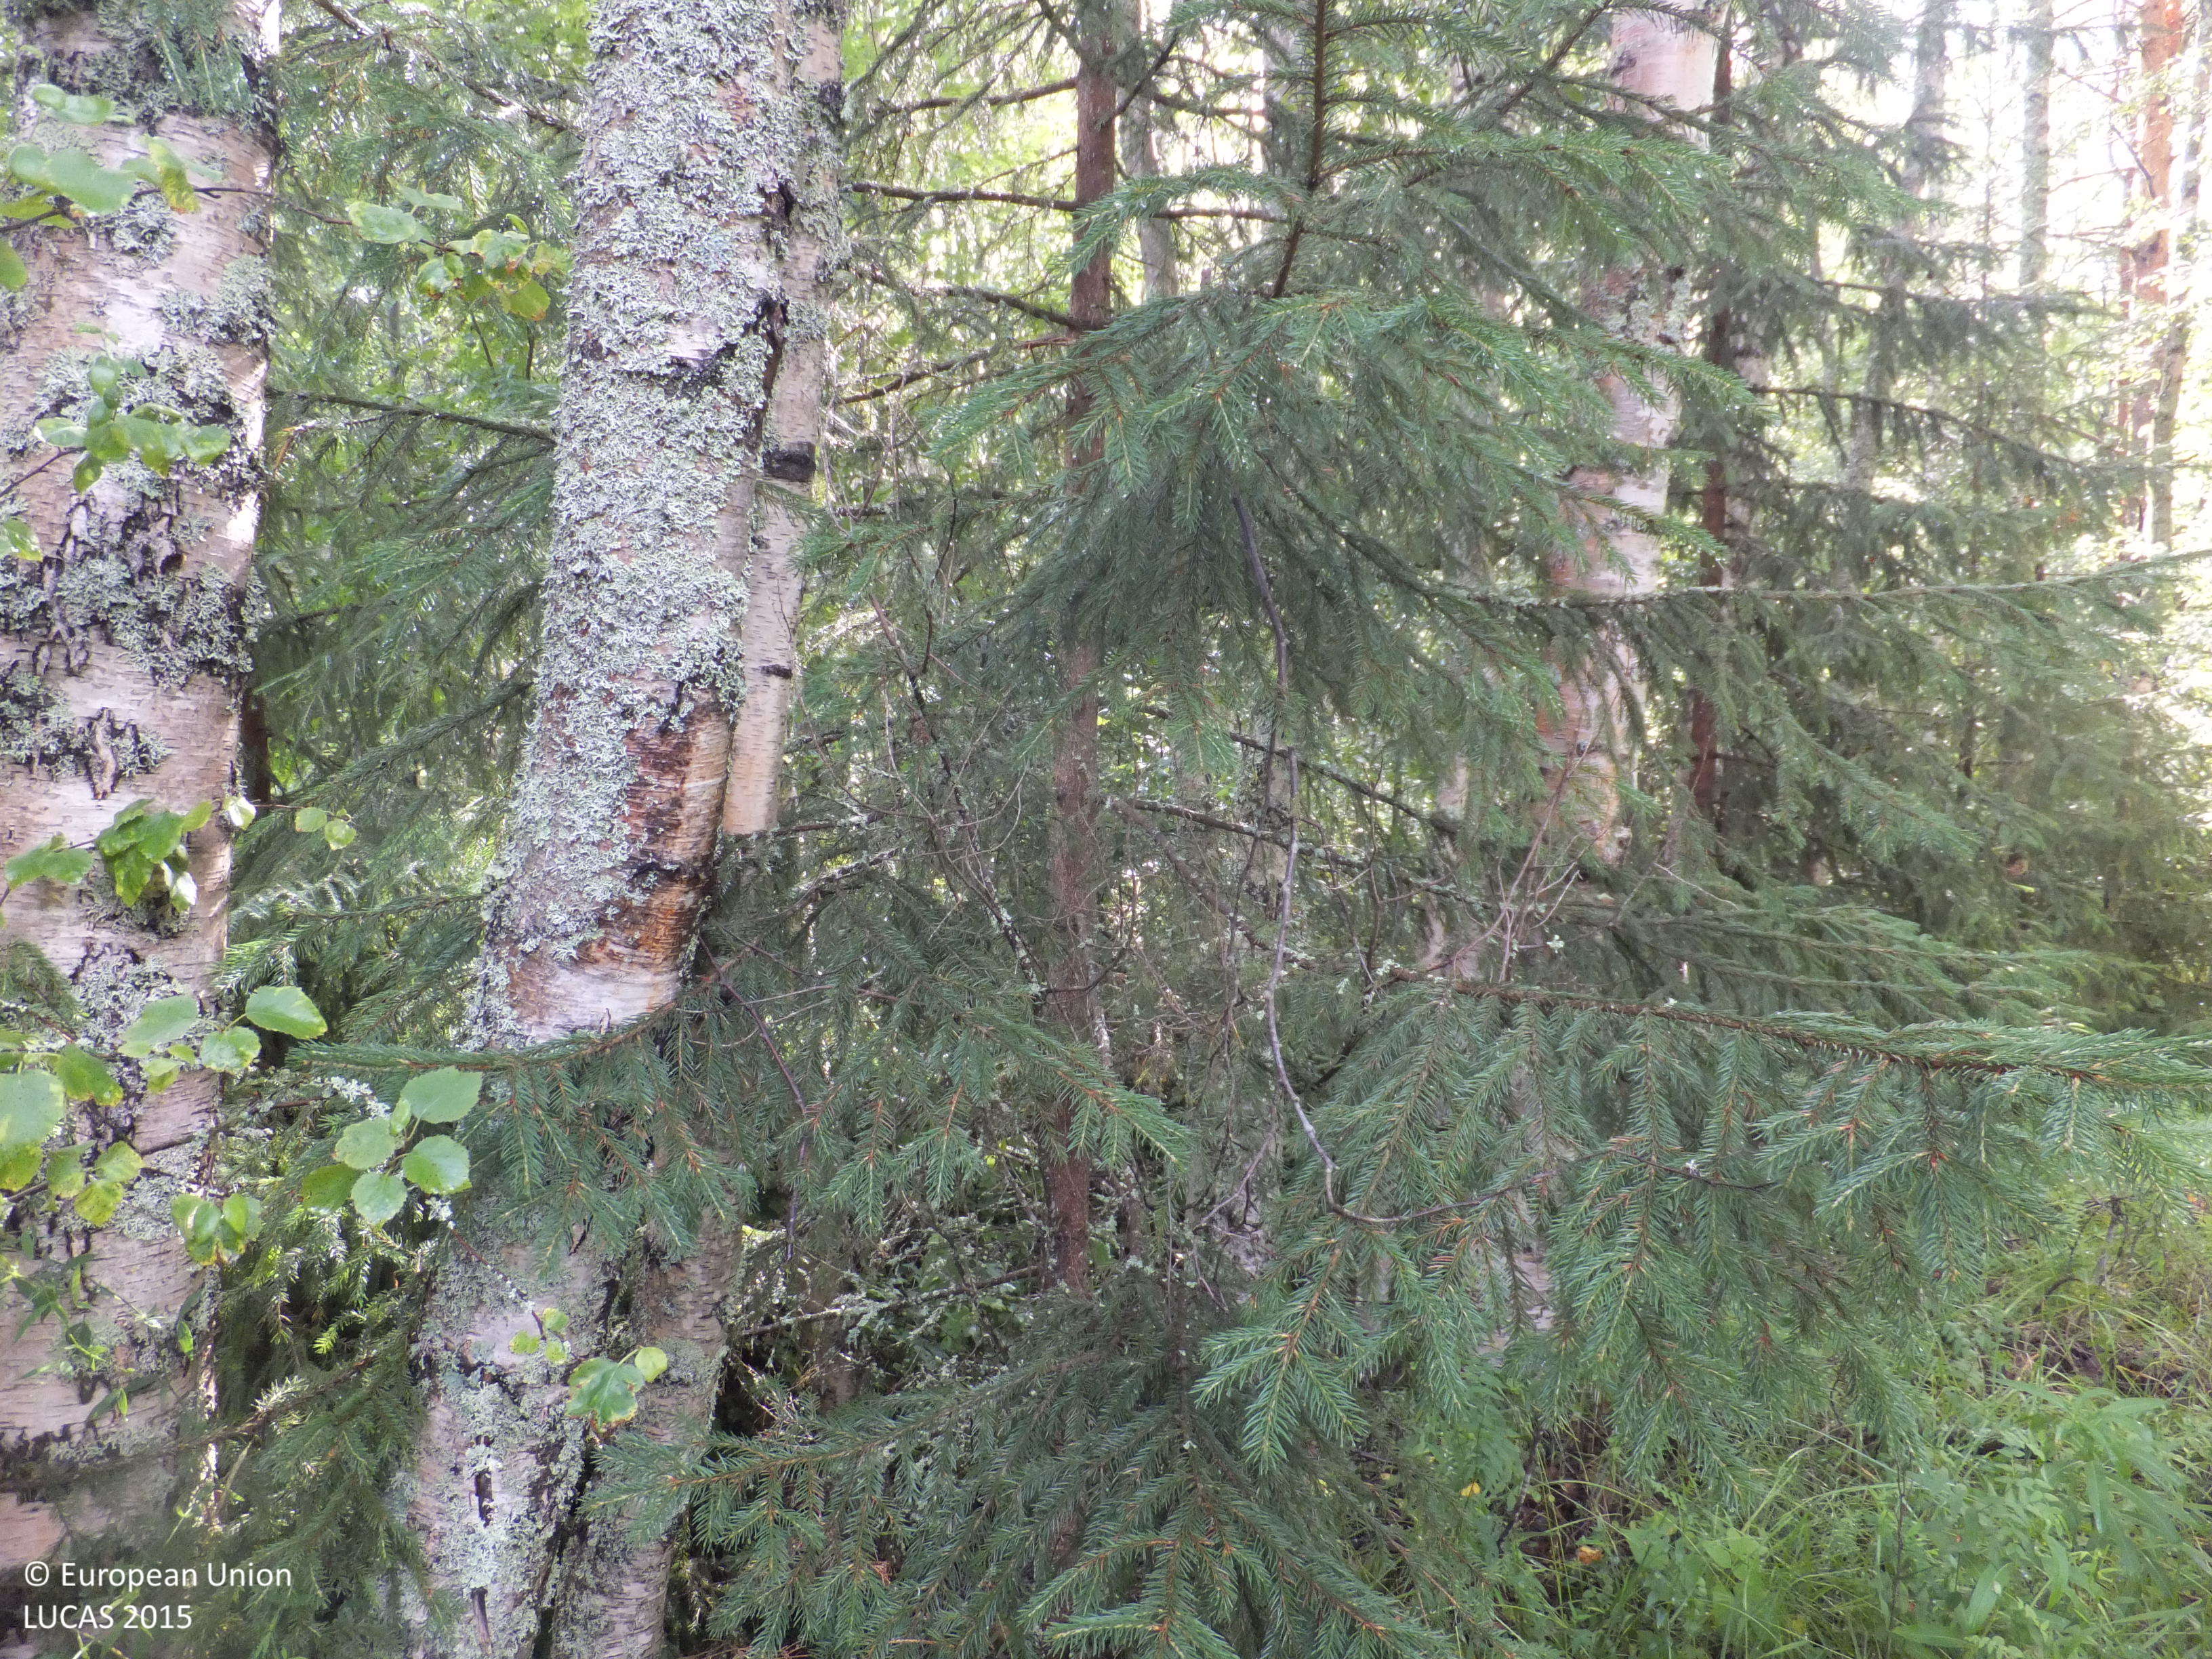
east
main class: Woodland
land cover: Spruce dominated mixed woodland
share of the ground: 50 - 75 %
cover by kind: herbaceous plants 40 %, broadleaved forest trees 30 %, coniferous forest trees 20 %, shrubs 10 %
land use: Semi-natural and natural areas not in use
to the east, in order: Spruce dominated mixed woodland; Ditches and canals; Broadleaved woodland; Other mixed woodland; Tracks; Other mixed woodland; Tracks; Grass margins; Ditches and canals; Other mixed woodland; Spruce dominated mixed woodland; Tracks; Spruce dominated mixed woodland
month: July
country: FI
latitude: 63.1919
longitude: 21.9879
